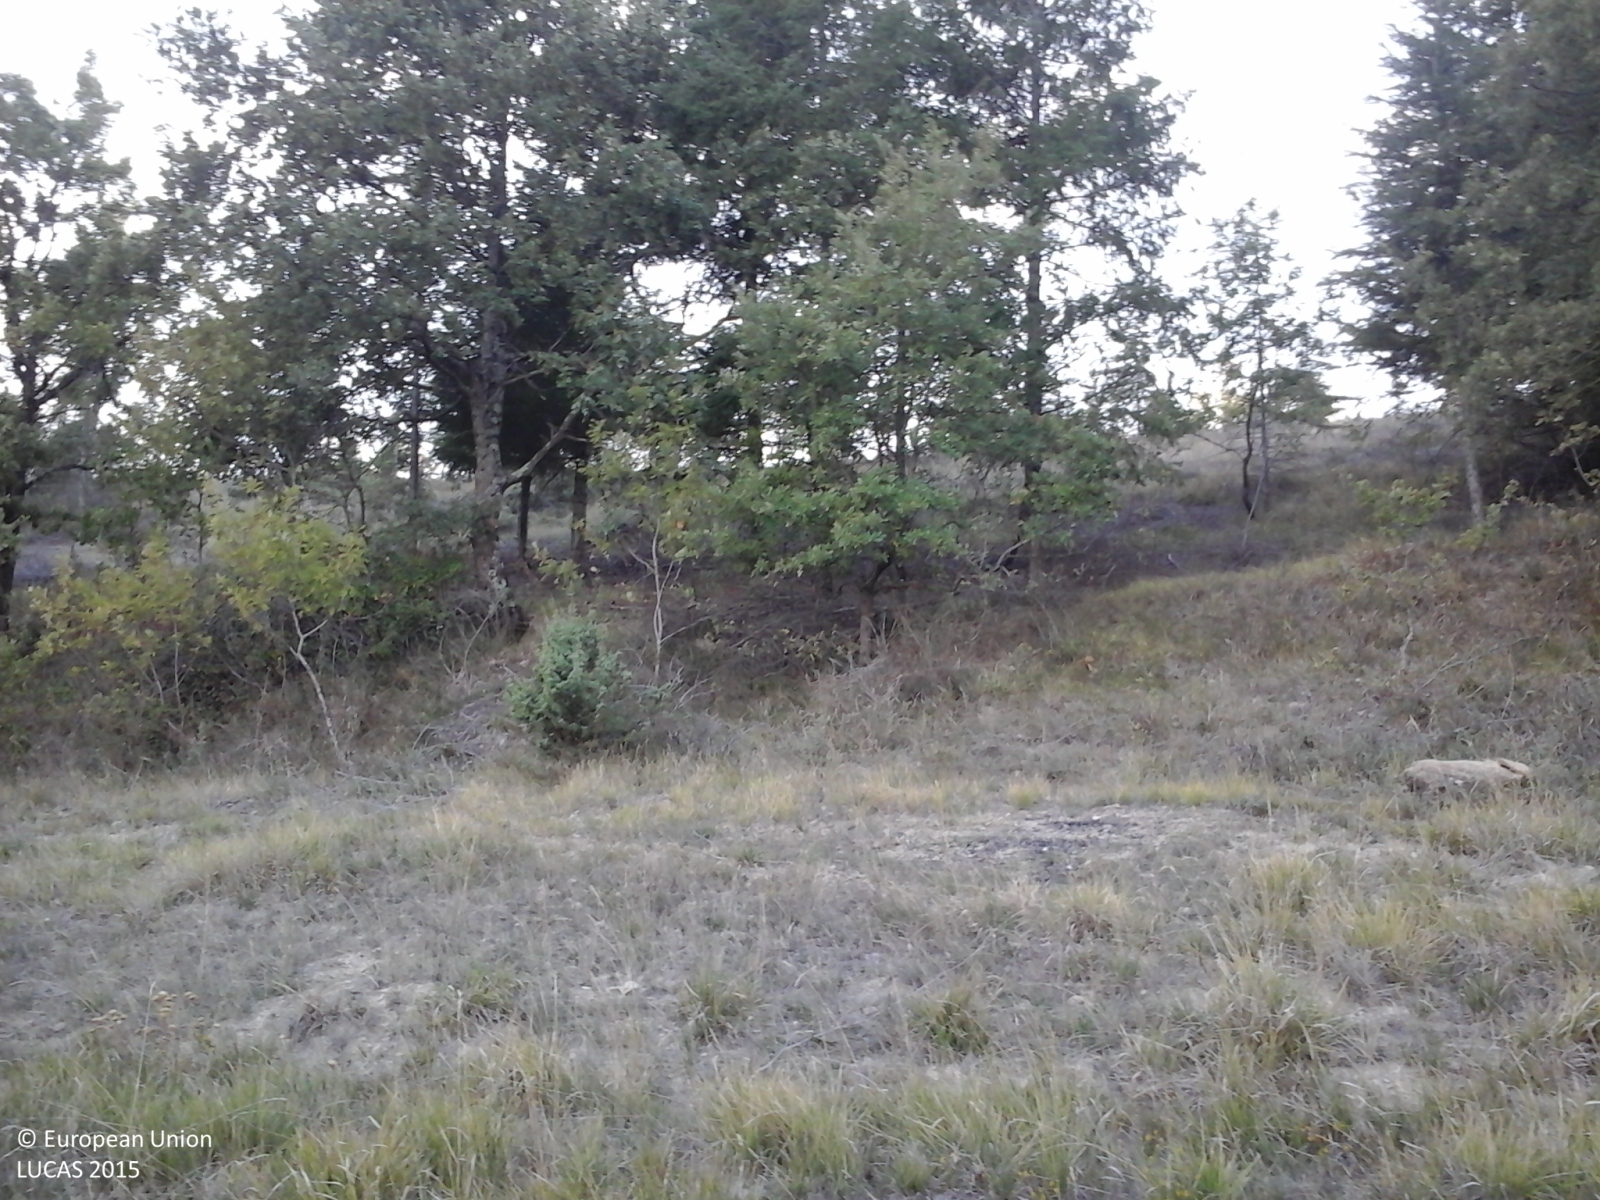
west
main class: Cropland
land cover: Olive groves
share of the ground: 25 - 50 %
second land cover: Spontaneously vegetated surfaces
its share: 50 - 75 %
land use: Agriculture (excluding fallow land and kitchen gardens)
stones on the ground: 10 - 25 %
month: September
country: IT
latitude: 43.1885
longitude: 12.2698
